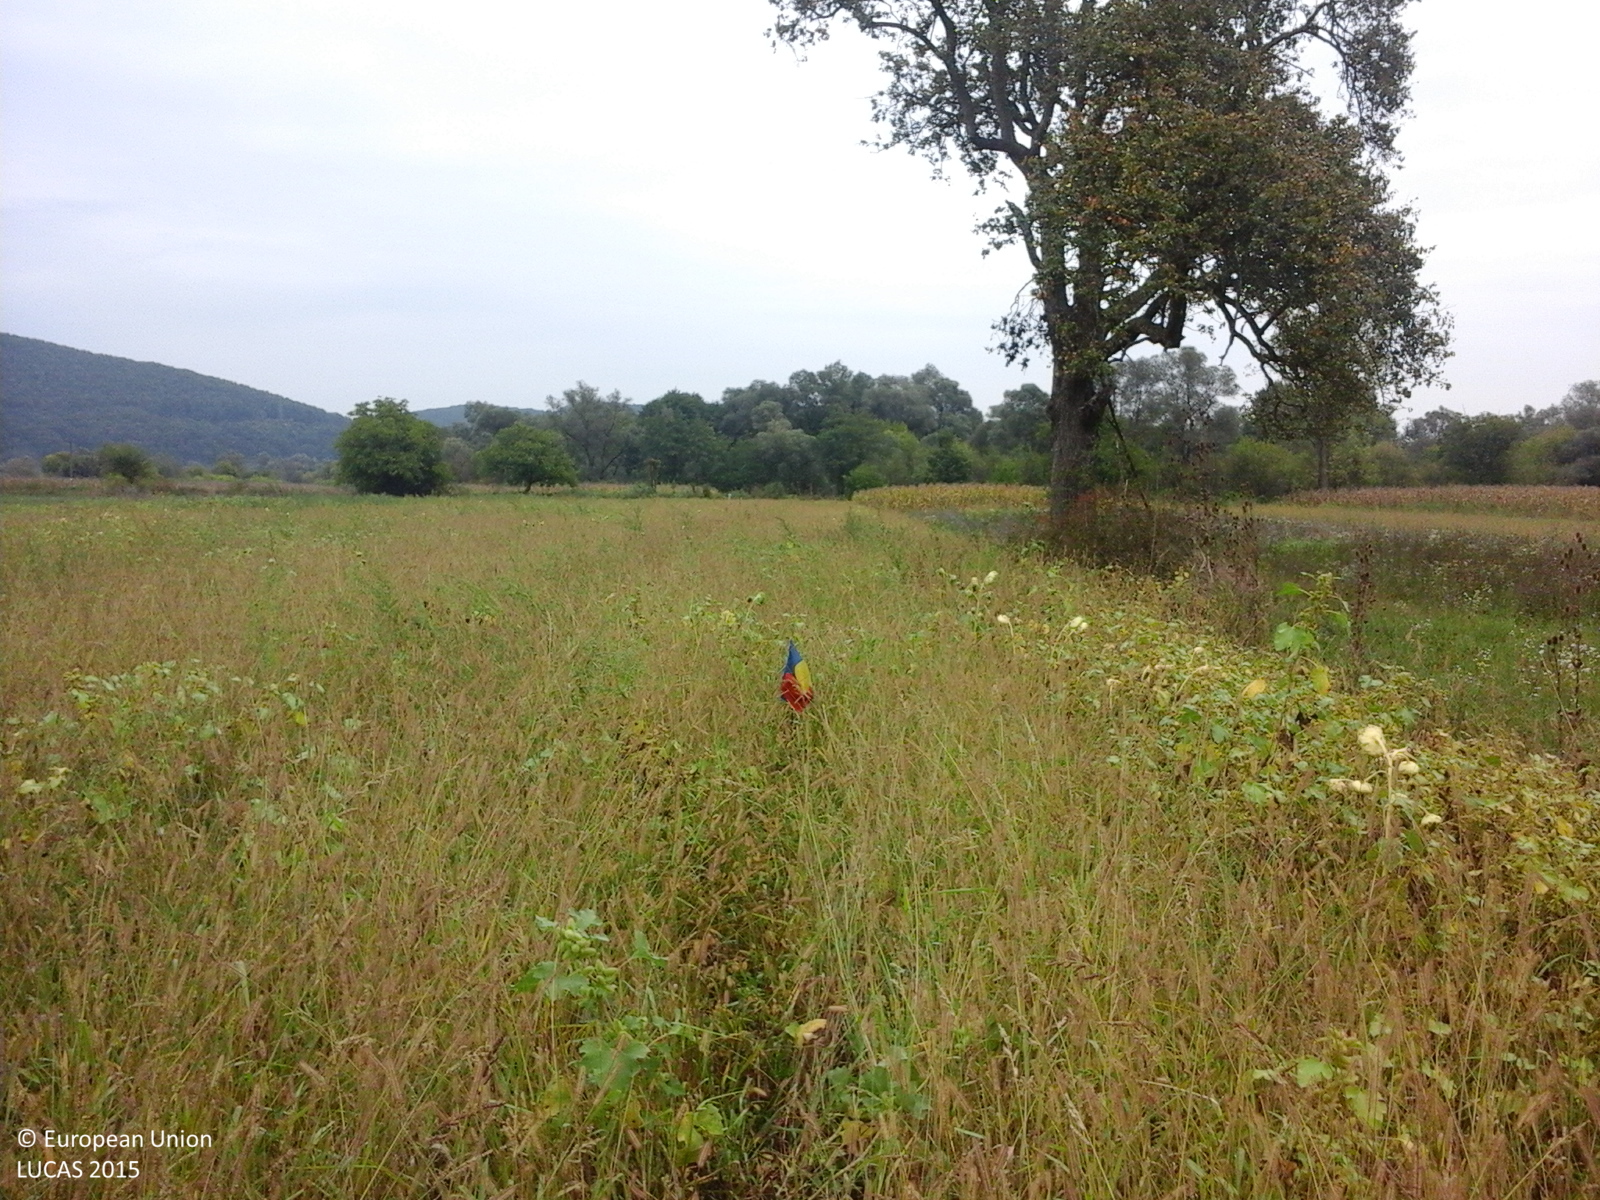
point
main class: Grassland
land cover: Spontaneously vegetated surfaces
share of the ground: > 75 %
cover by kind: herbaceous plants 100 %
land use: Fallow land
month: September
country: RO
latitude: 45.9877
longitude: 22.2705
